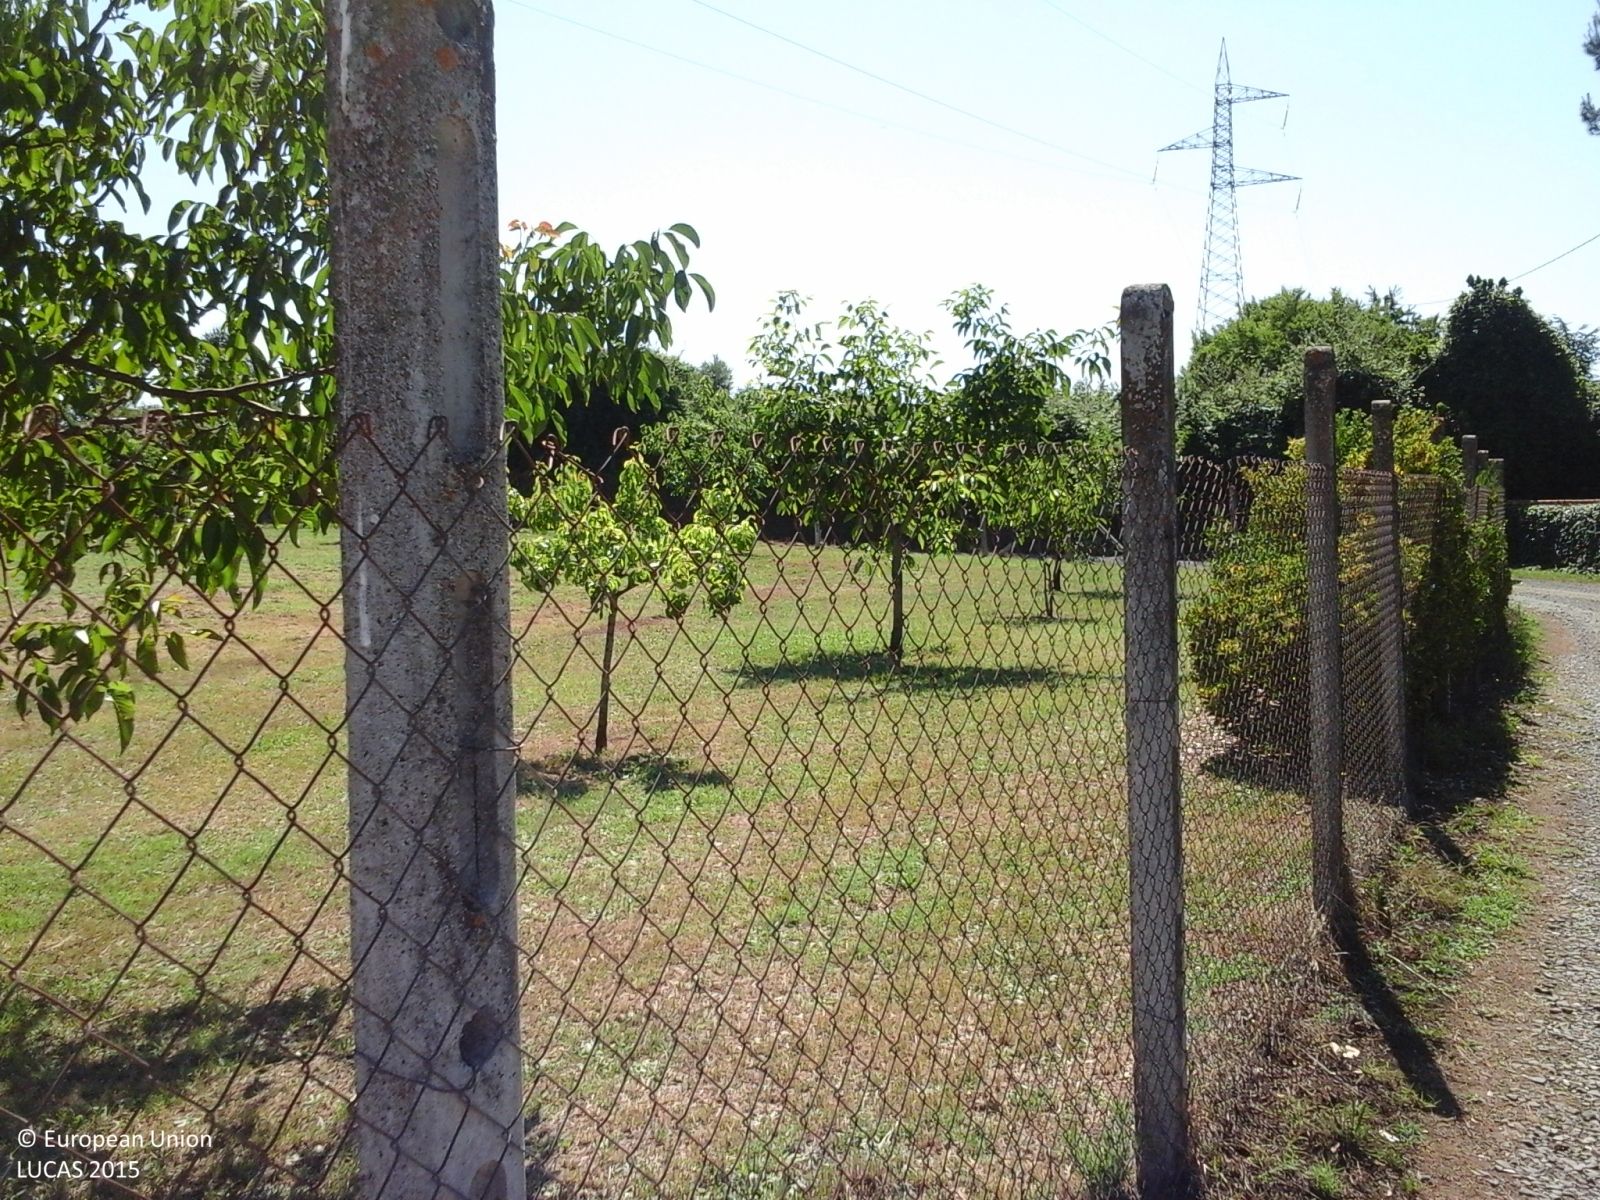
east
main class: Grassland
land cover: Grassland without tree/shrub cover
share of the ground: > 75 %
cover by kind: herbaceous plants 100 %
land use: Agriculture (excluding fallow land and kitchen gardens)
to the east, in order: Grassland without tree/shrub cover; Artificial constructions in urban areas; Grassland without tree/shrub cover; Olive groves; Artificial constructions in urban areas; Grassland without tree/shrub cover; Artificial constructions in urban areas; Grassland without tree/shrub cover; Fences; Managed hedges; Grassland without tree/shrub cover; Tracks; Grass margins; Electric lines; Tracks; Electric lines; Fences; Lines of trees; Grassland without tree/shrub cover; Paved roads, cycling and walking lanes; Fences; Barley
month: July
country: IT
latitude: 41.8188
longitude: 12.8425
